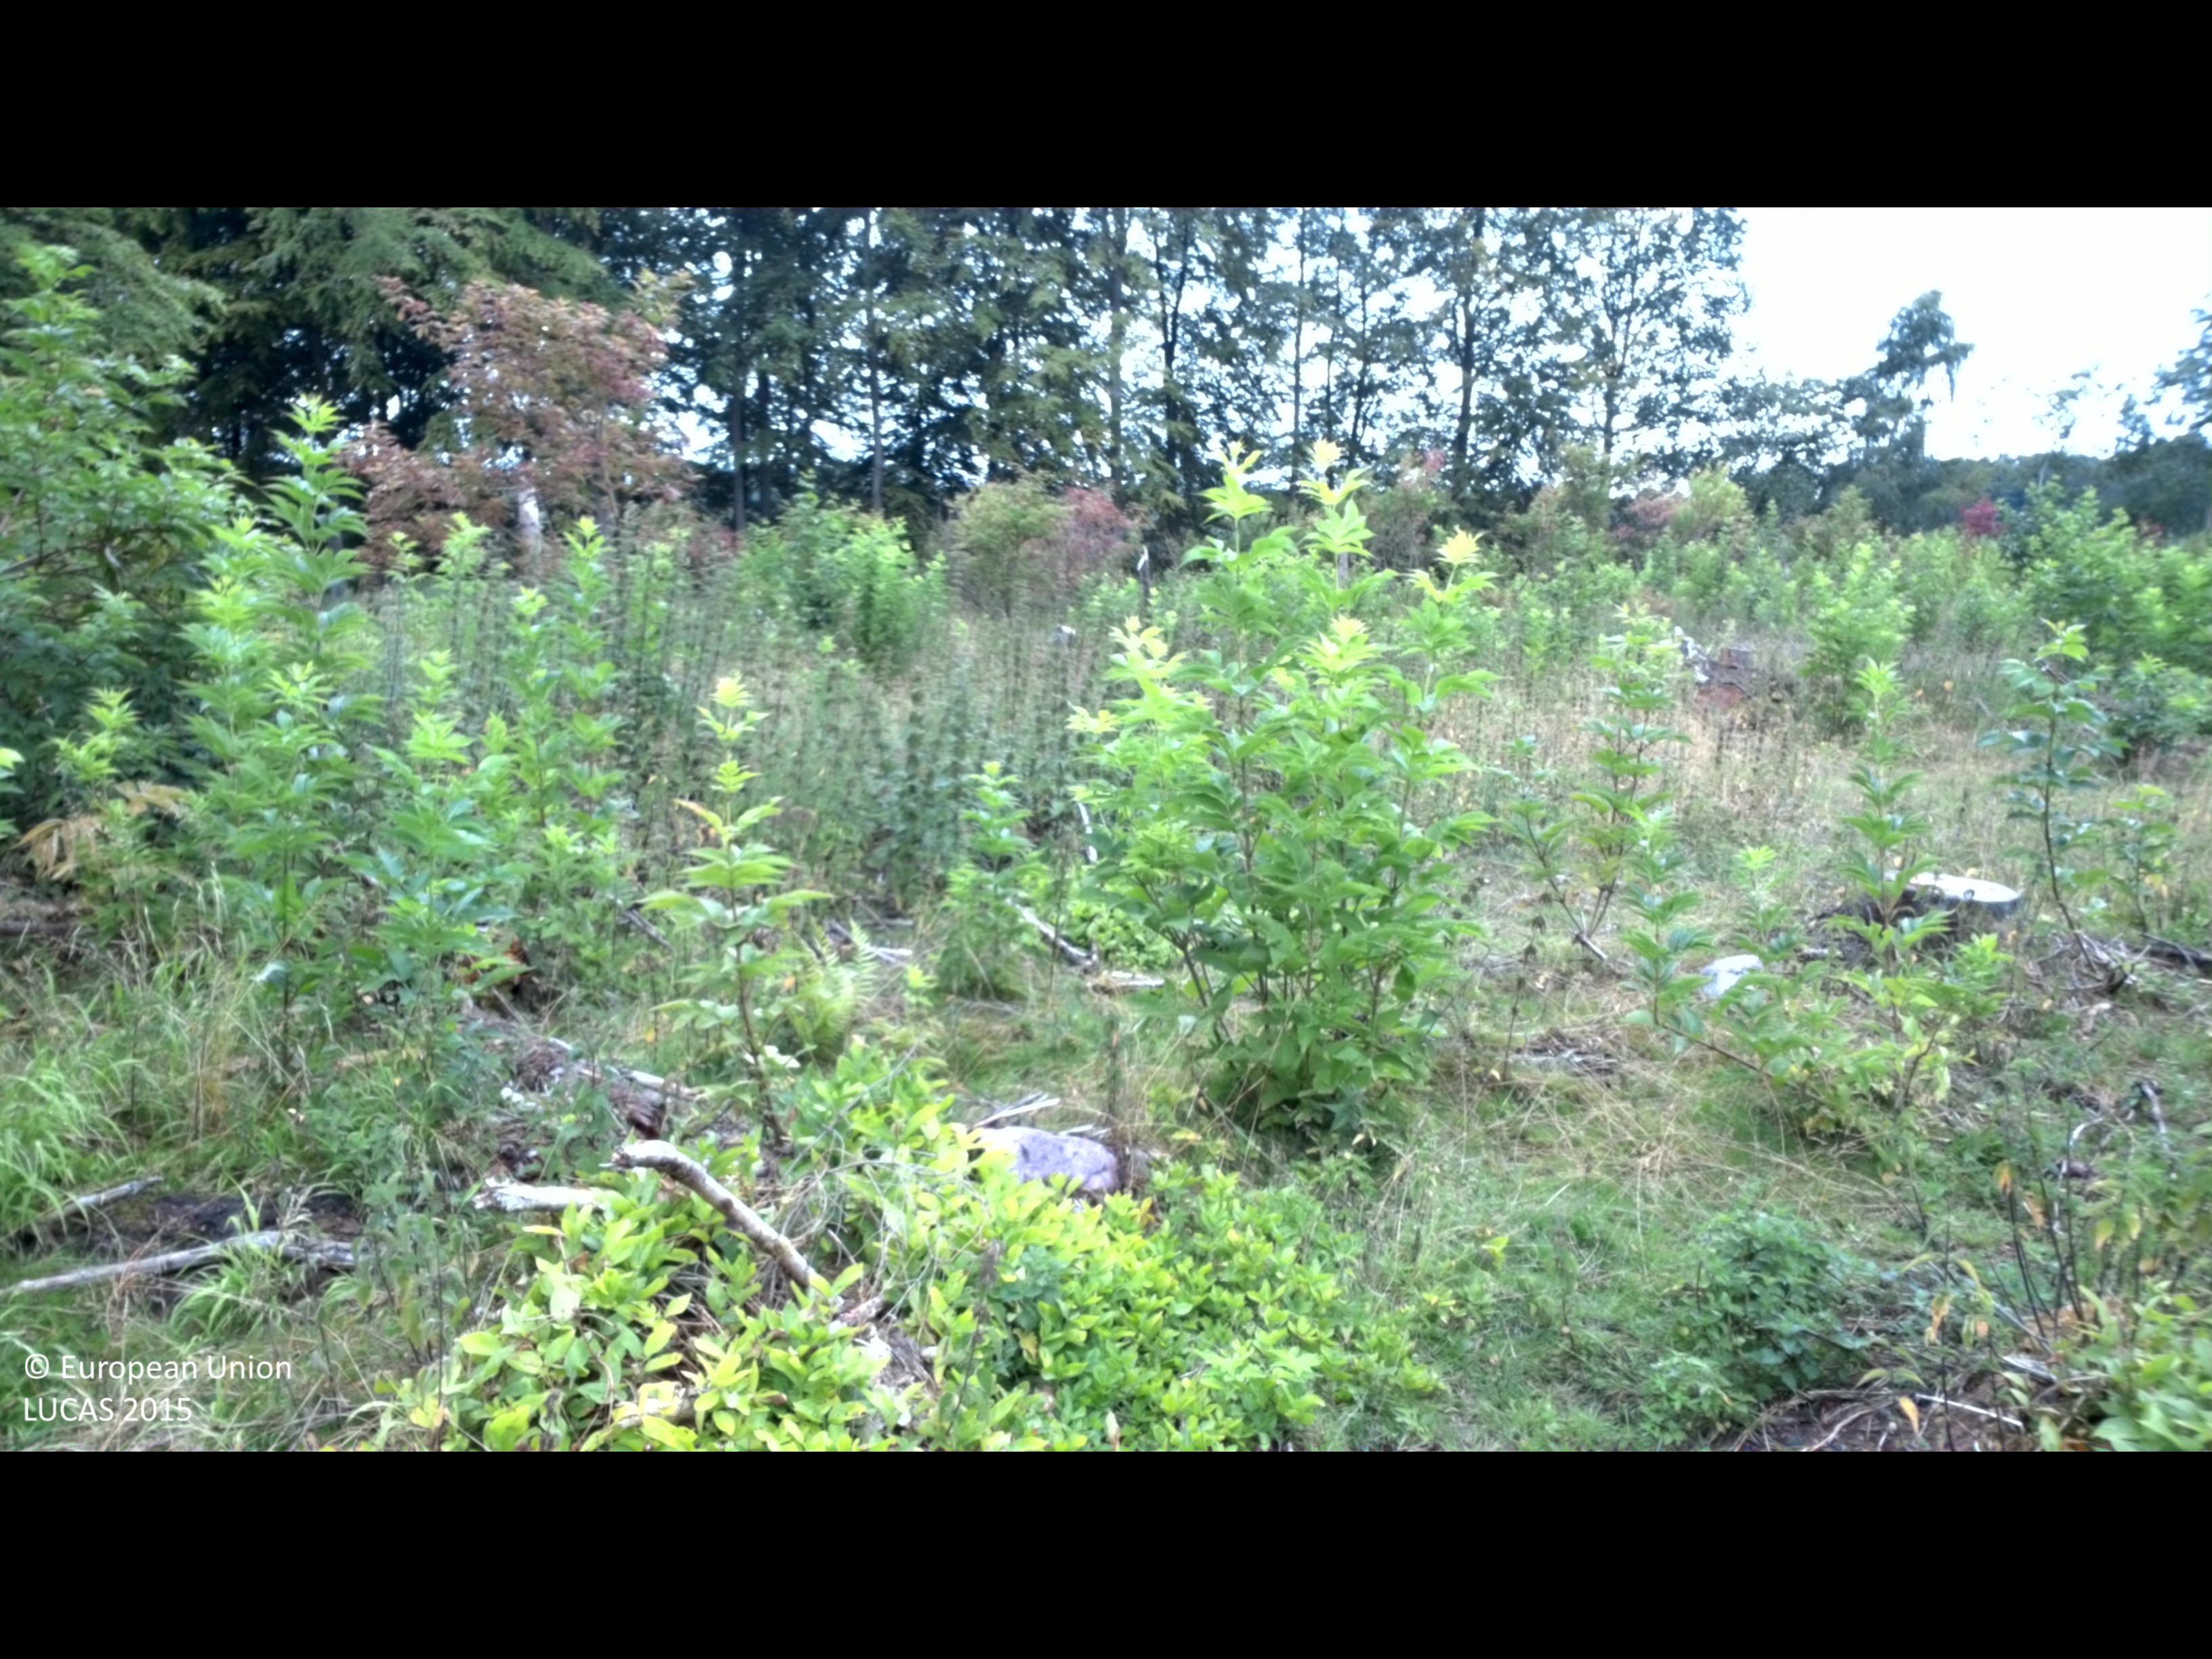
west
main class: Shrubland
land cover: Shrubland without tree cover
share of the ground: > 75 %
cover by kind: shrubs 65 %, herbaceous plants 35 %
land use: Forestry
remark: Clear cut
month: July
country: SE
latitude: 55.8911
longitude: 14.0114
